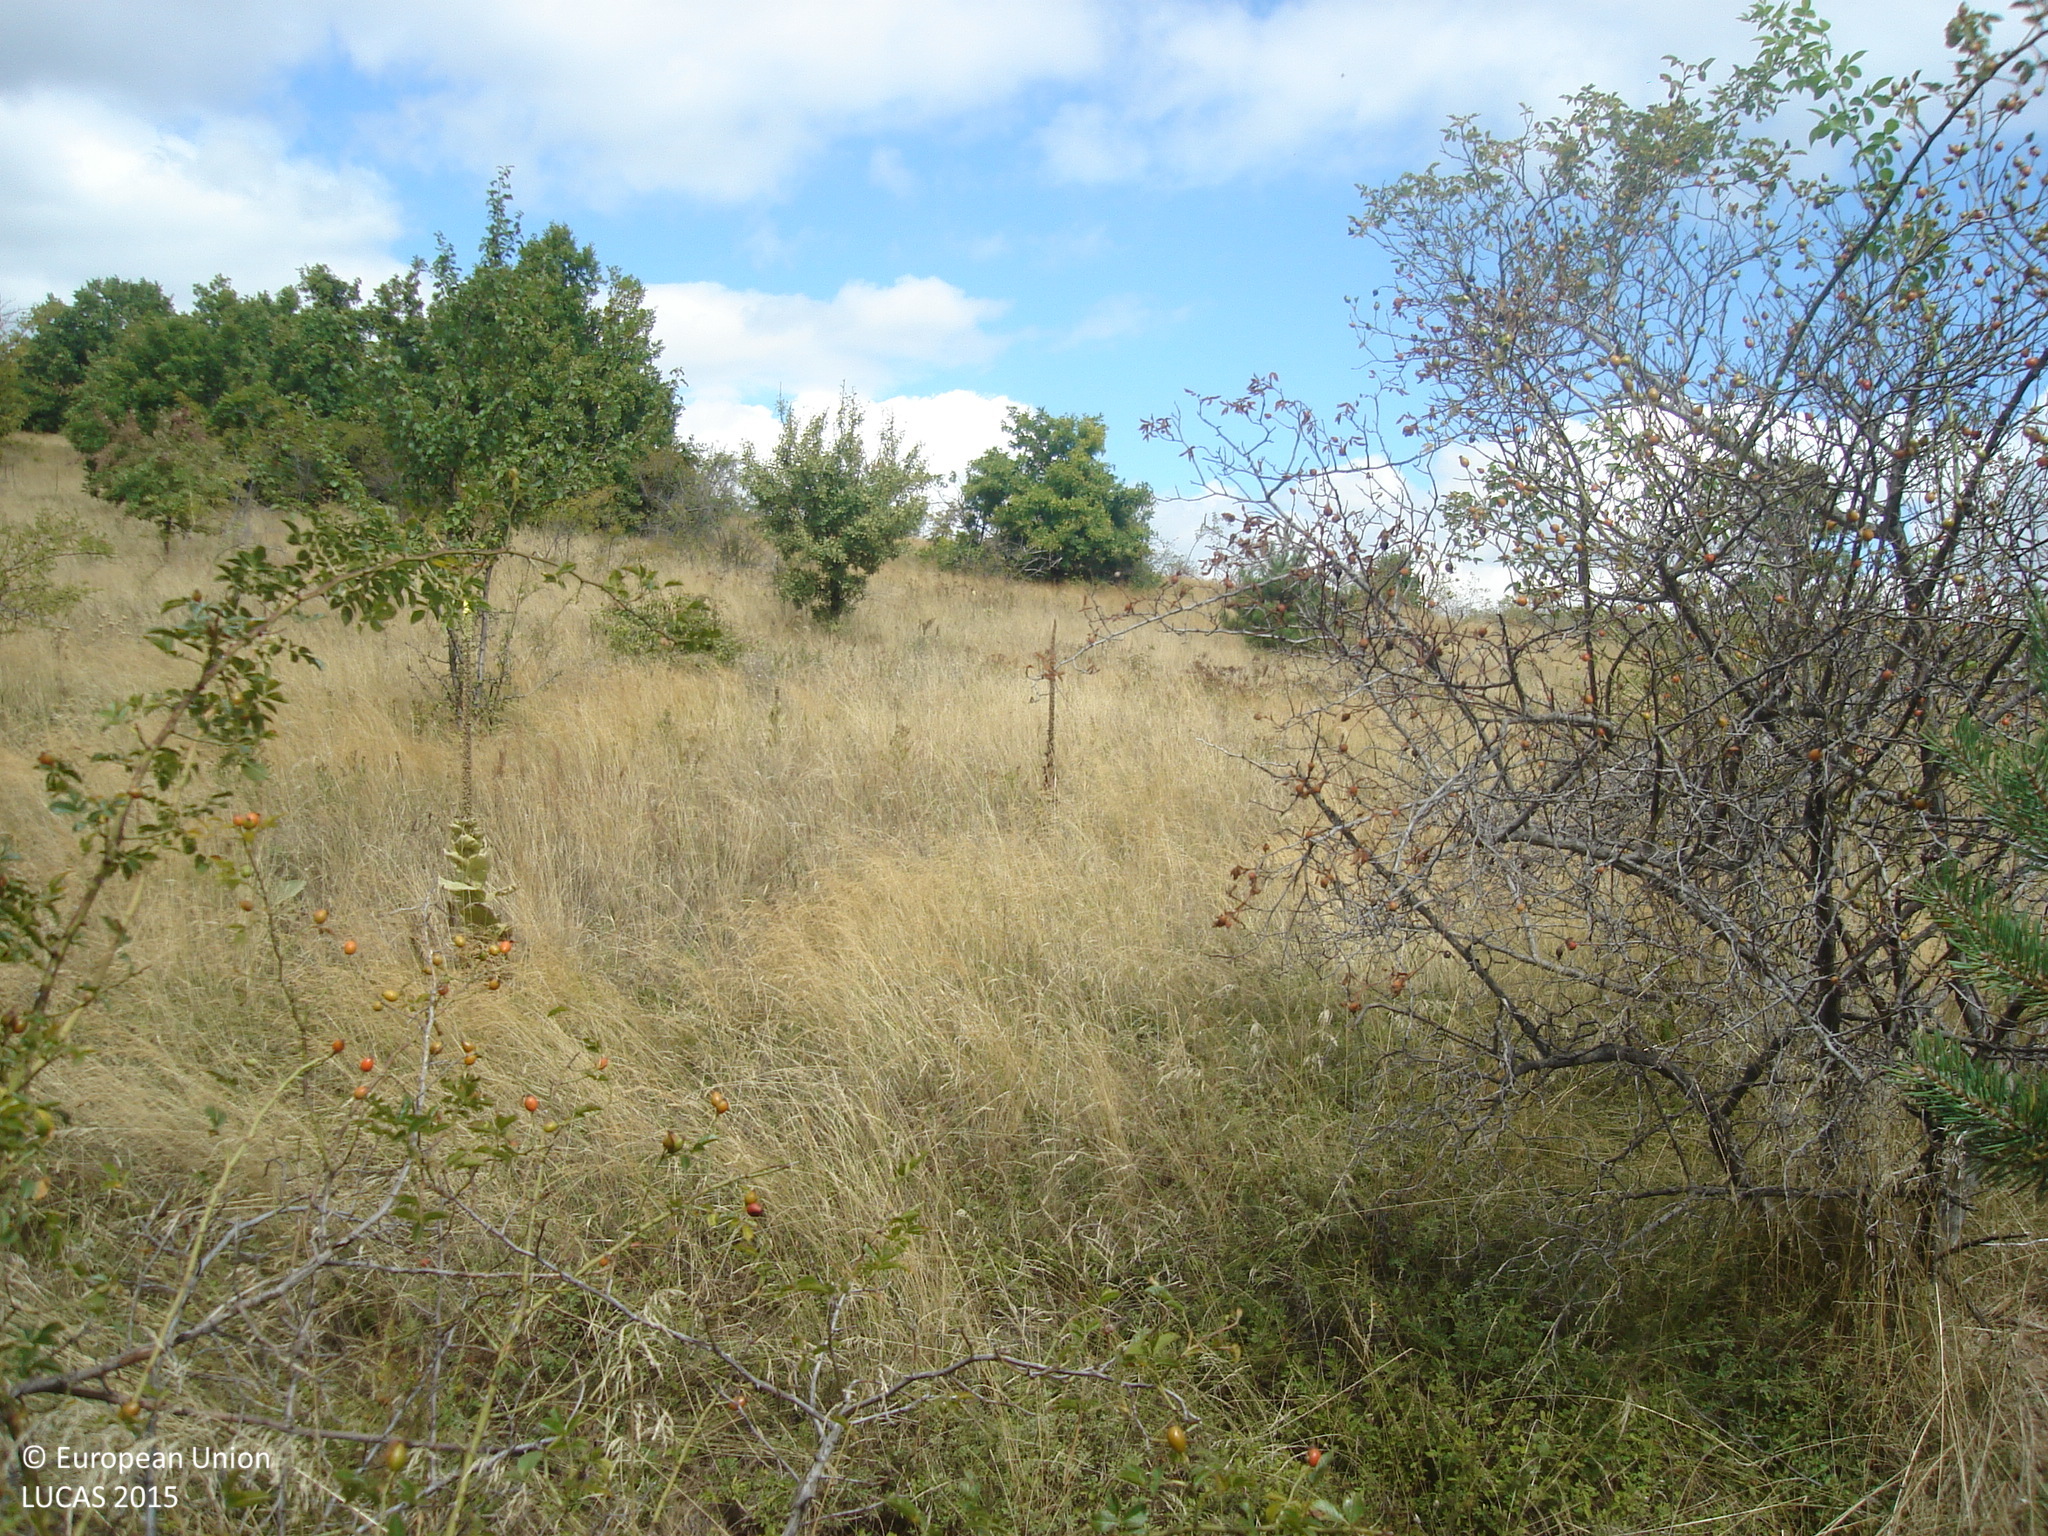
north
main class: Grassland
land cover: Grassland with sparse tree/shrub cover
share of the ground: > 75 %
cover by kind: herbaceous plants 85 %, shrubs 10 %, coniferous forest trees 5 %
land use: Semi-natural and natural areas not in use
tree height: > 5 m
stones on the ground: < 10 %
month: September
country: BG
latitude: 42.4543
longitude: 24.0633
